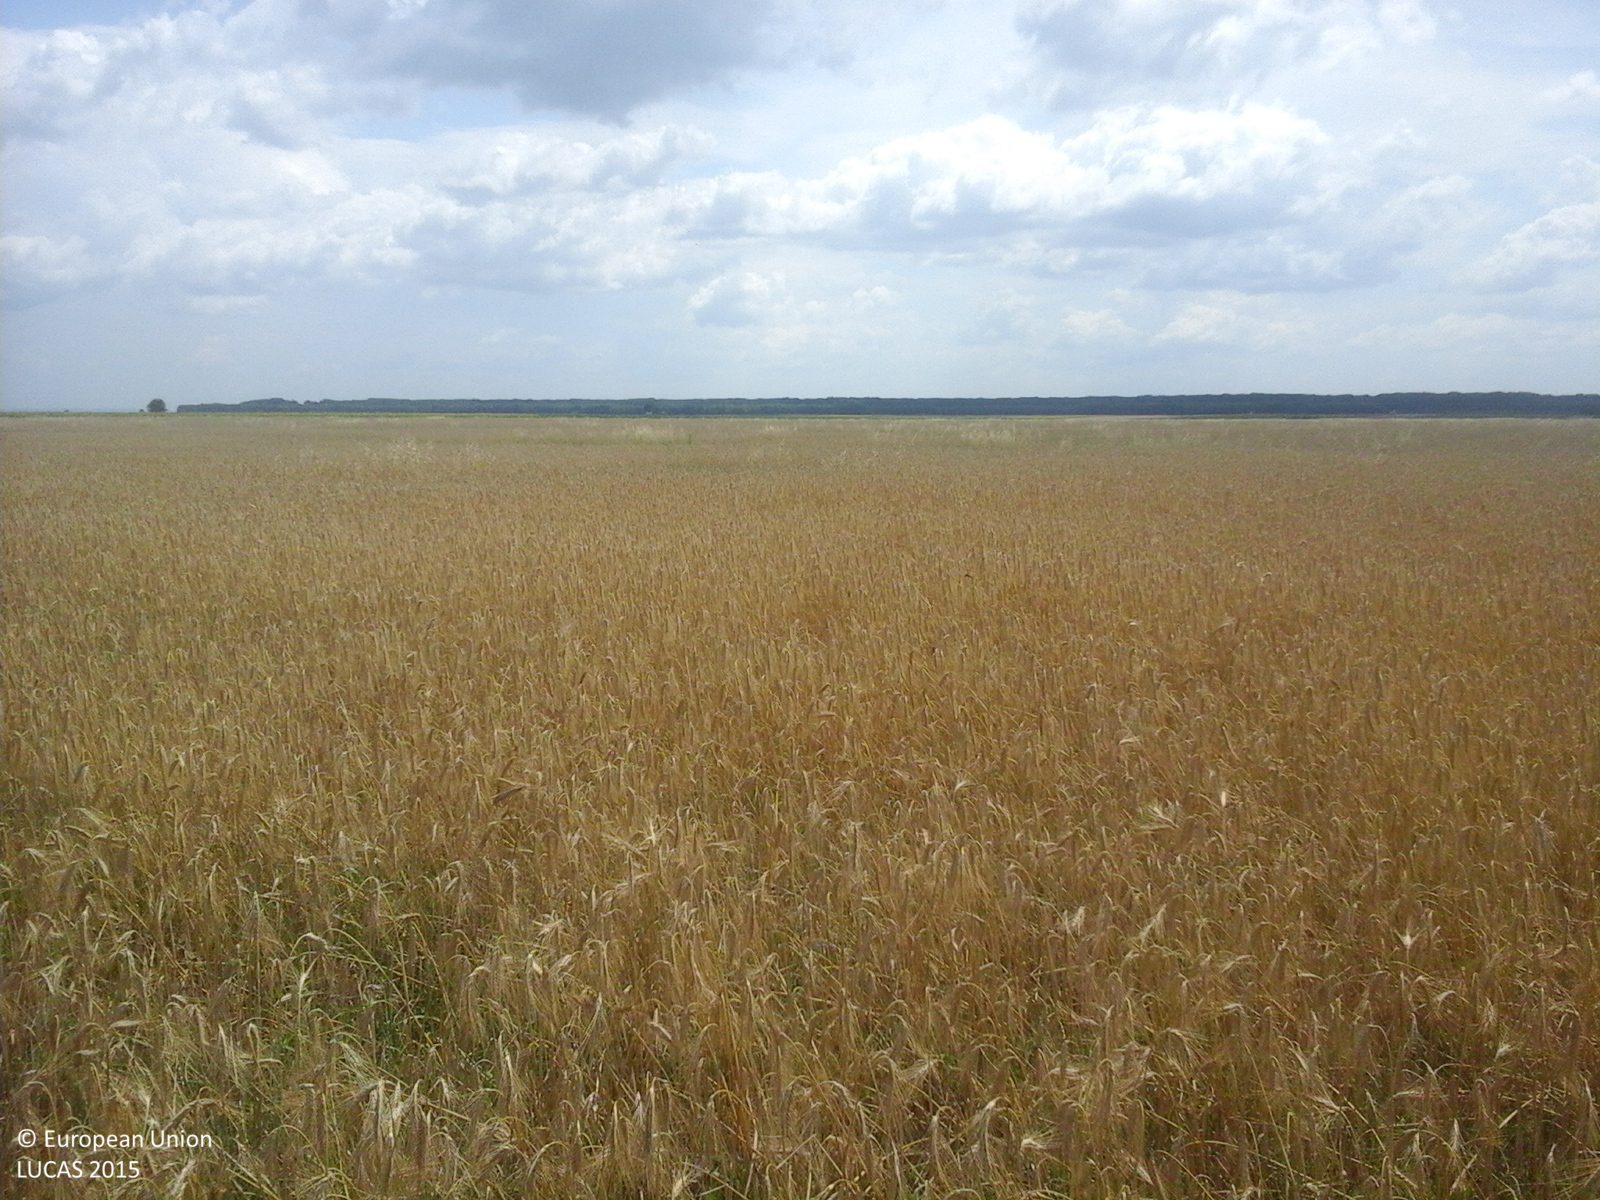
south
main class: Cropland
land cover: Common wheat
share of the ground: > 75 %
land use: Agriculture (excluding fallow land and kitchen gardens)
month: July
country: RO
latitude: 43.9109
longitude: 24.2440
